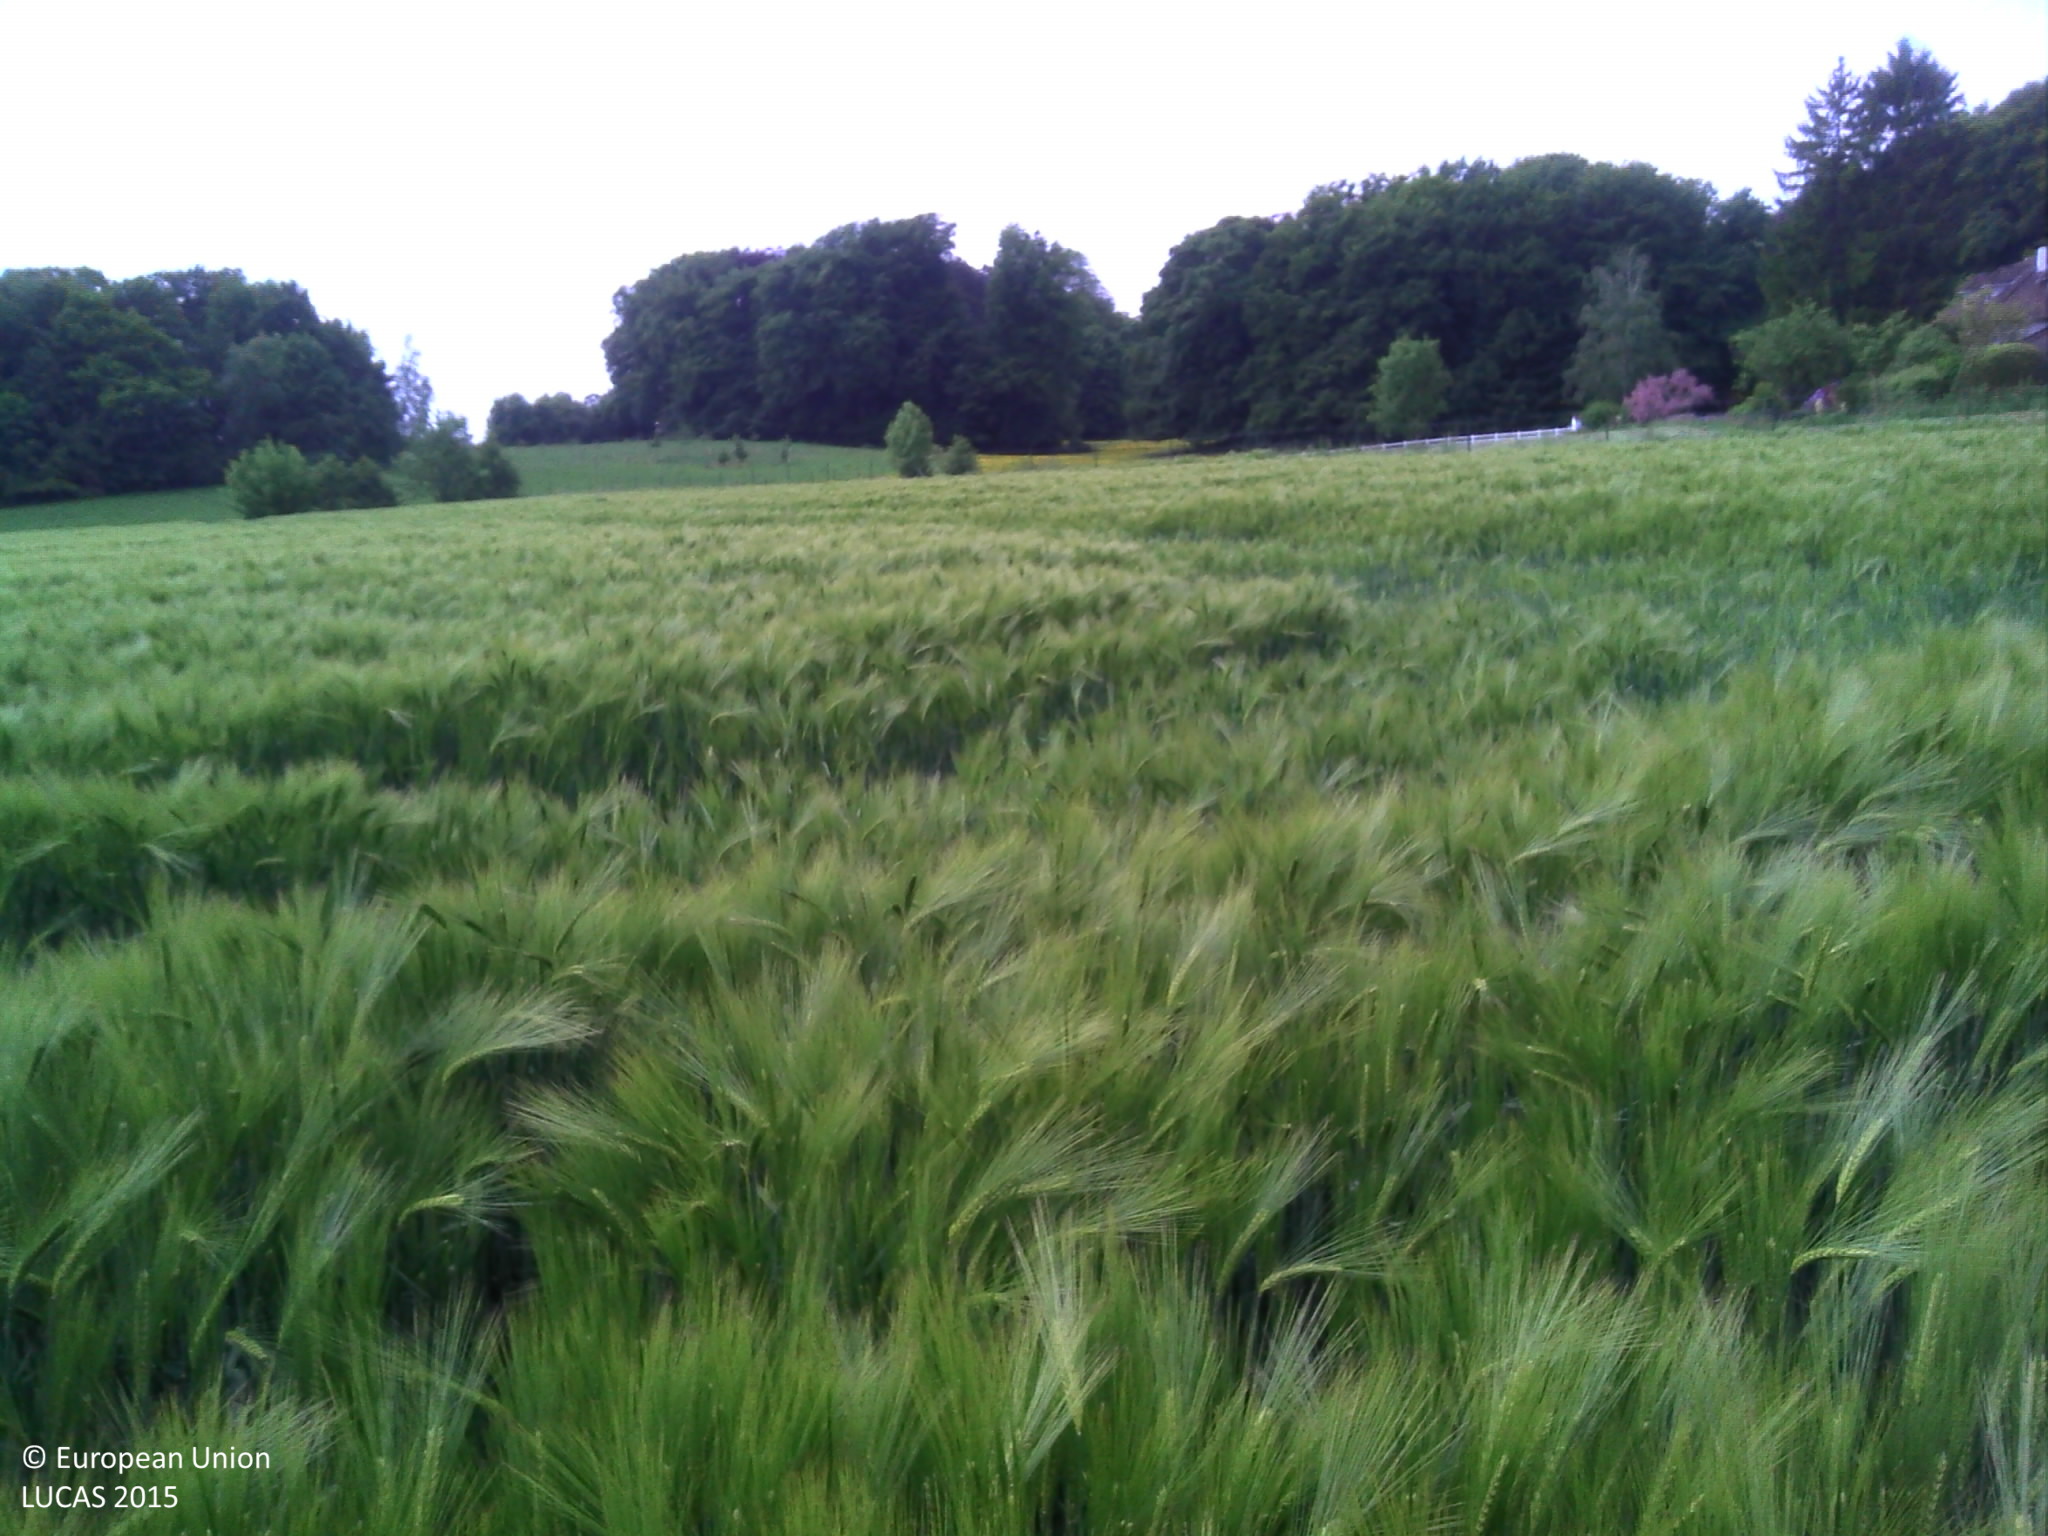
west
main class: Cropland
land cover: Barley
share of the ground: > 75 %
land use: Agriculture (excluding fallow land and kitchen gardens)
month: May
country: BE
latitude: 50.5372
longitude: 4.4790
